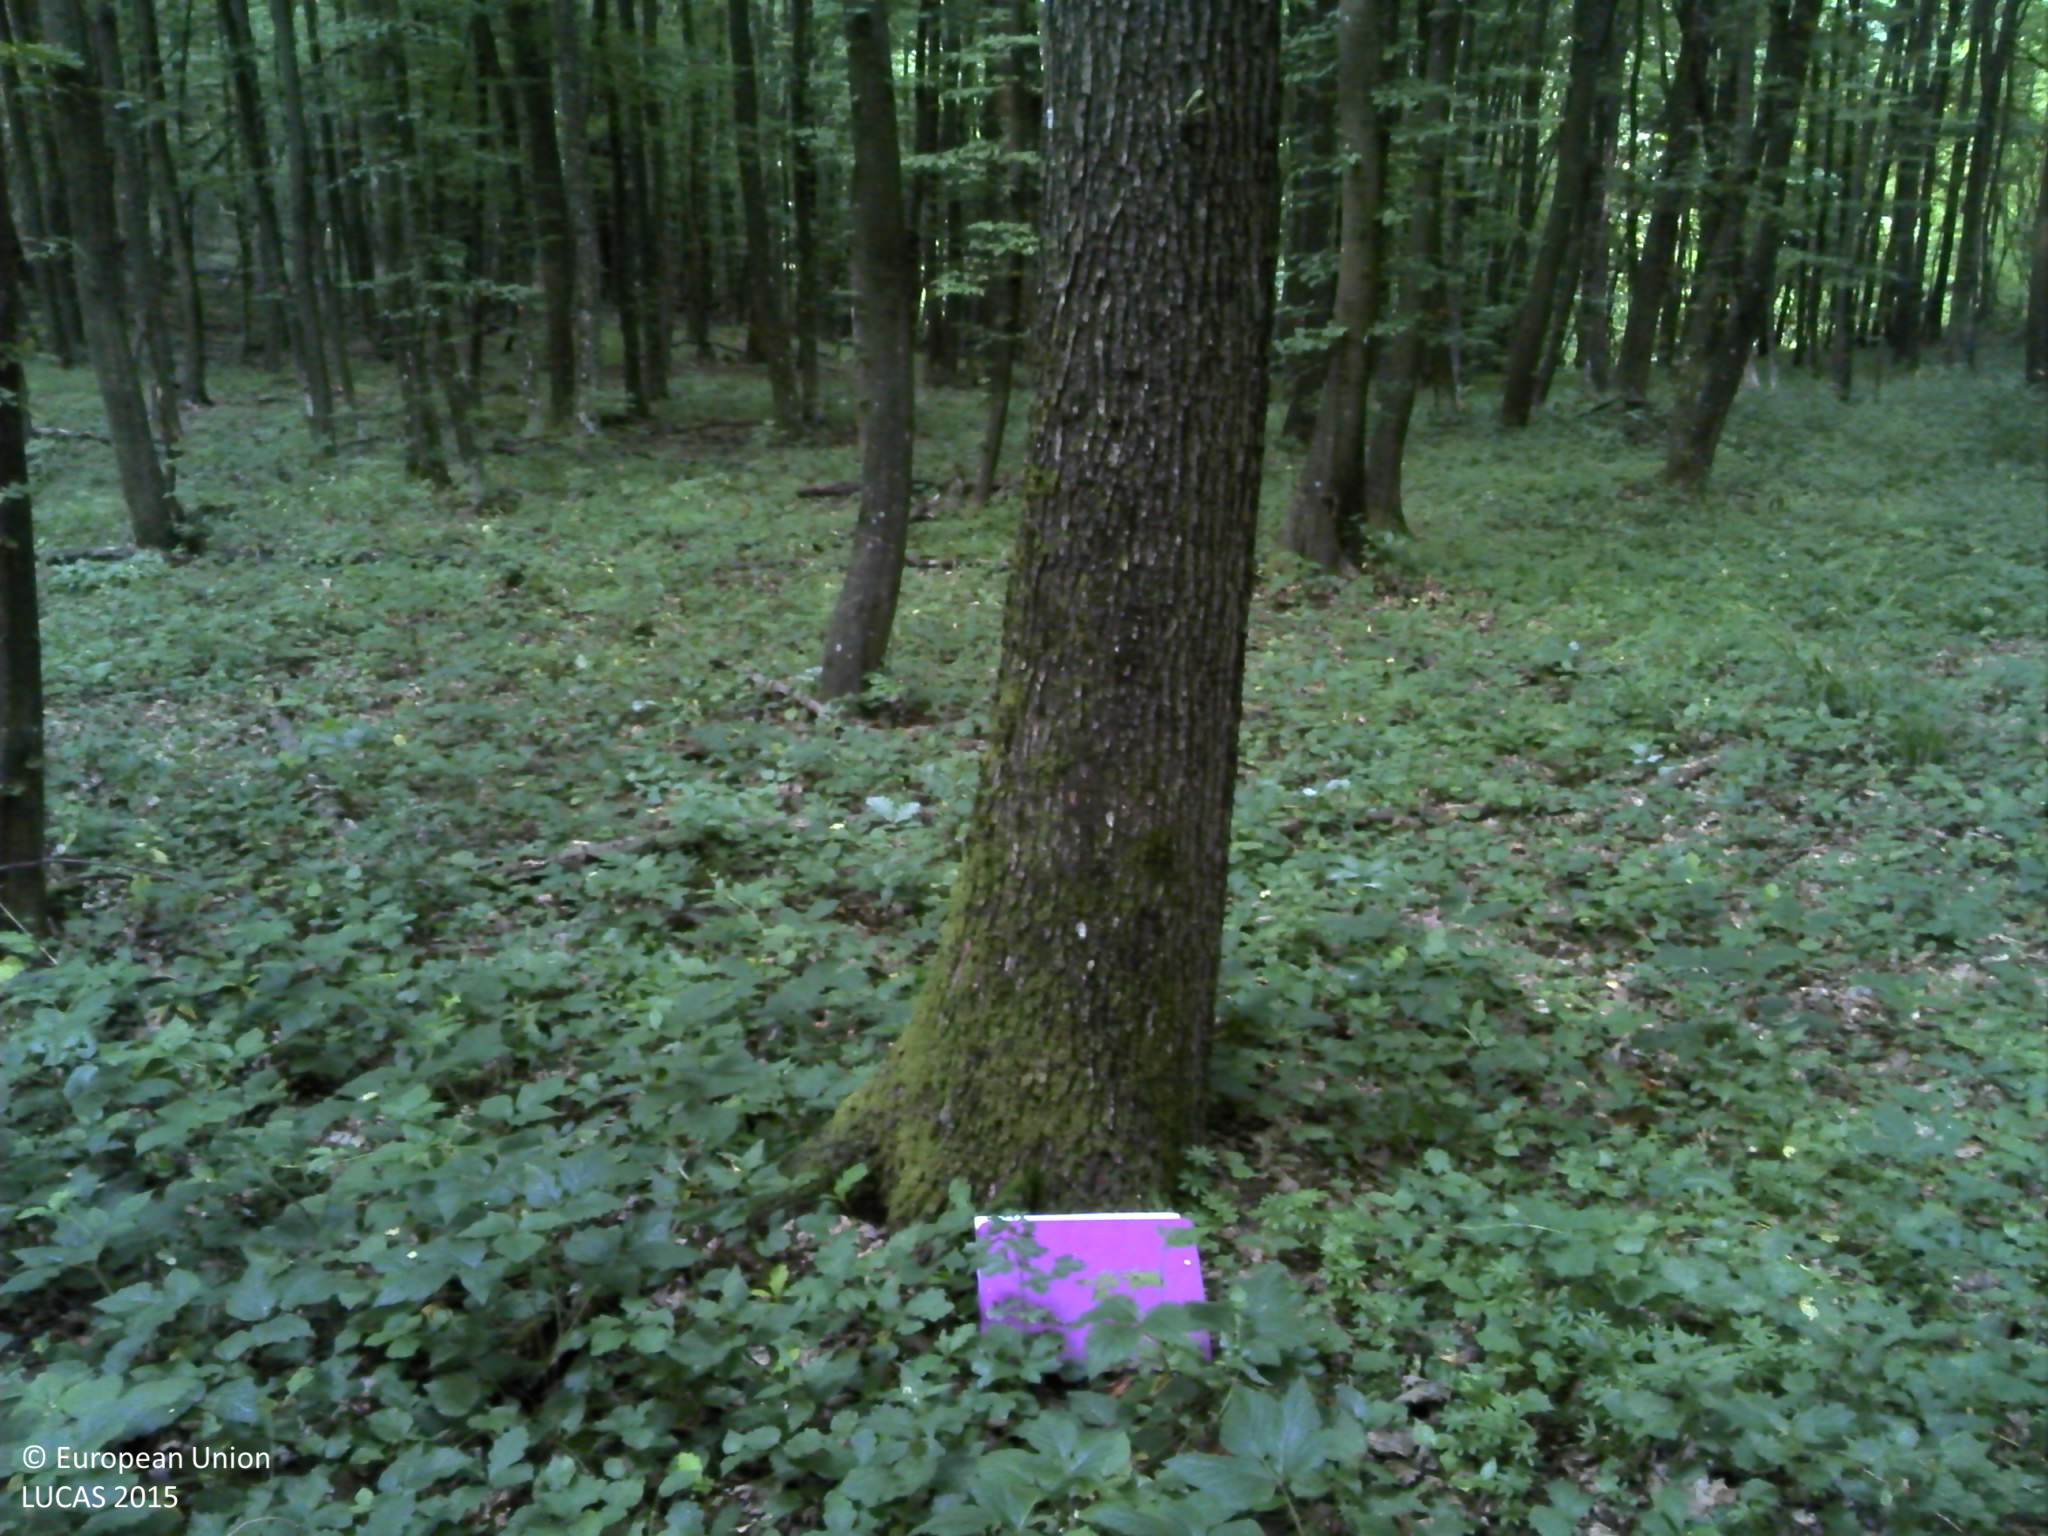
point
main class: Woodland
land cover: Broadleaved woodland
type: beech forest
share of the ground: > 75 %
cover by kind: broadleaved forest trees 90 %, herbaceous plants 5 %, lichens and mosses 5 %
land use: Forestry
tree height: > 5 m
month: June
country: HR
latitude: 45.2597
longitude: 18.1722
